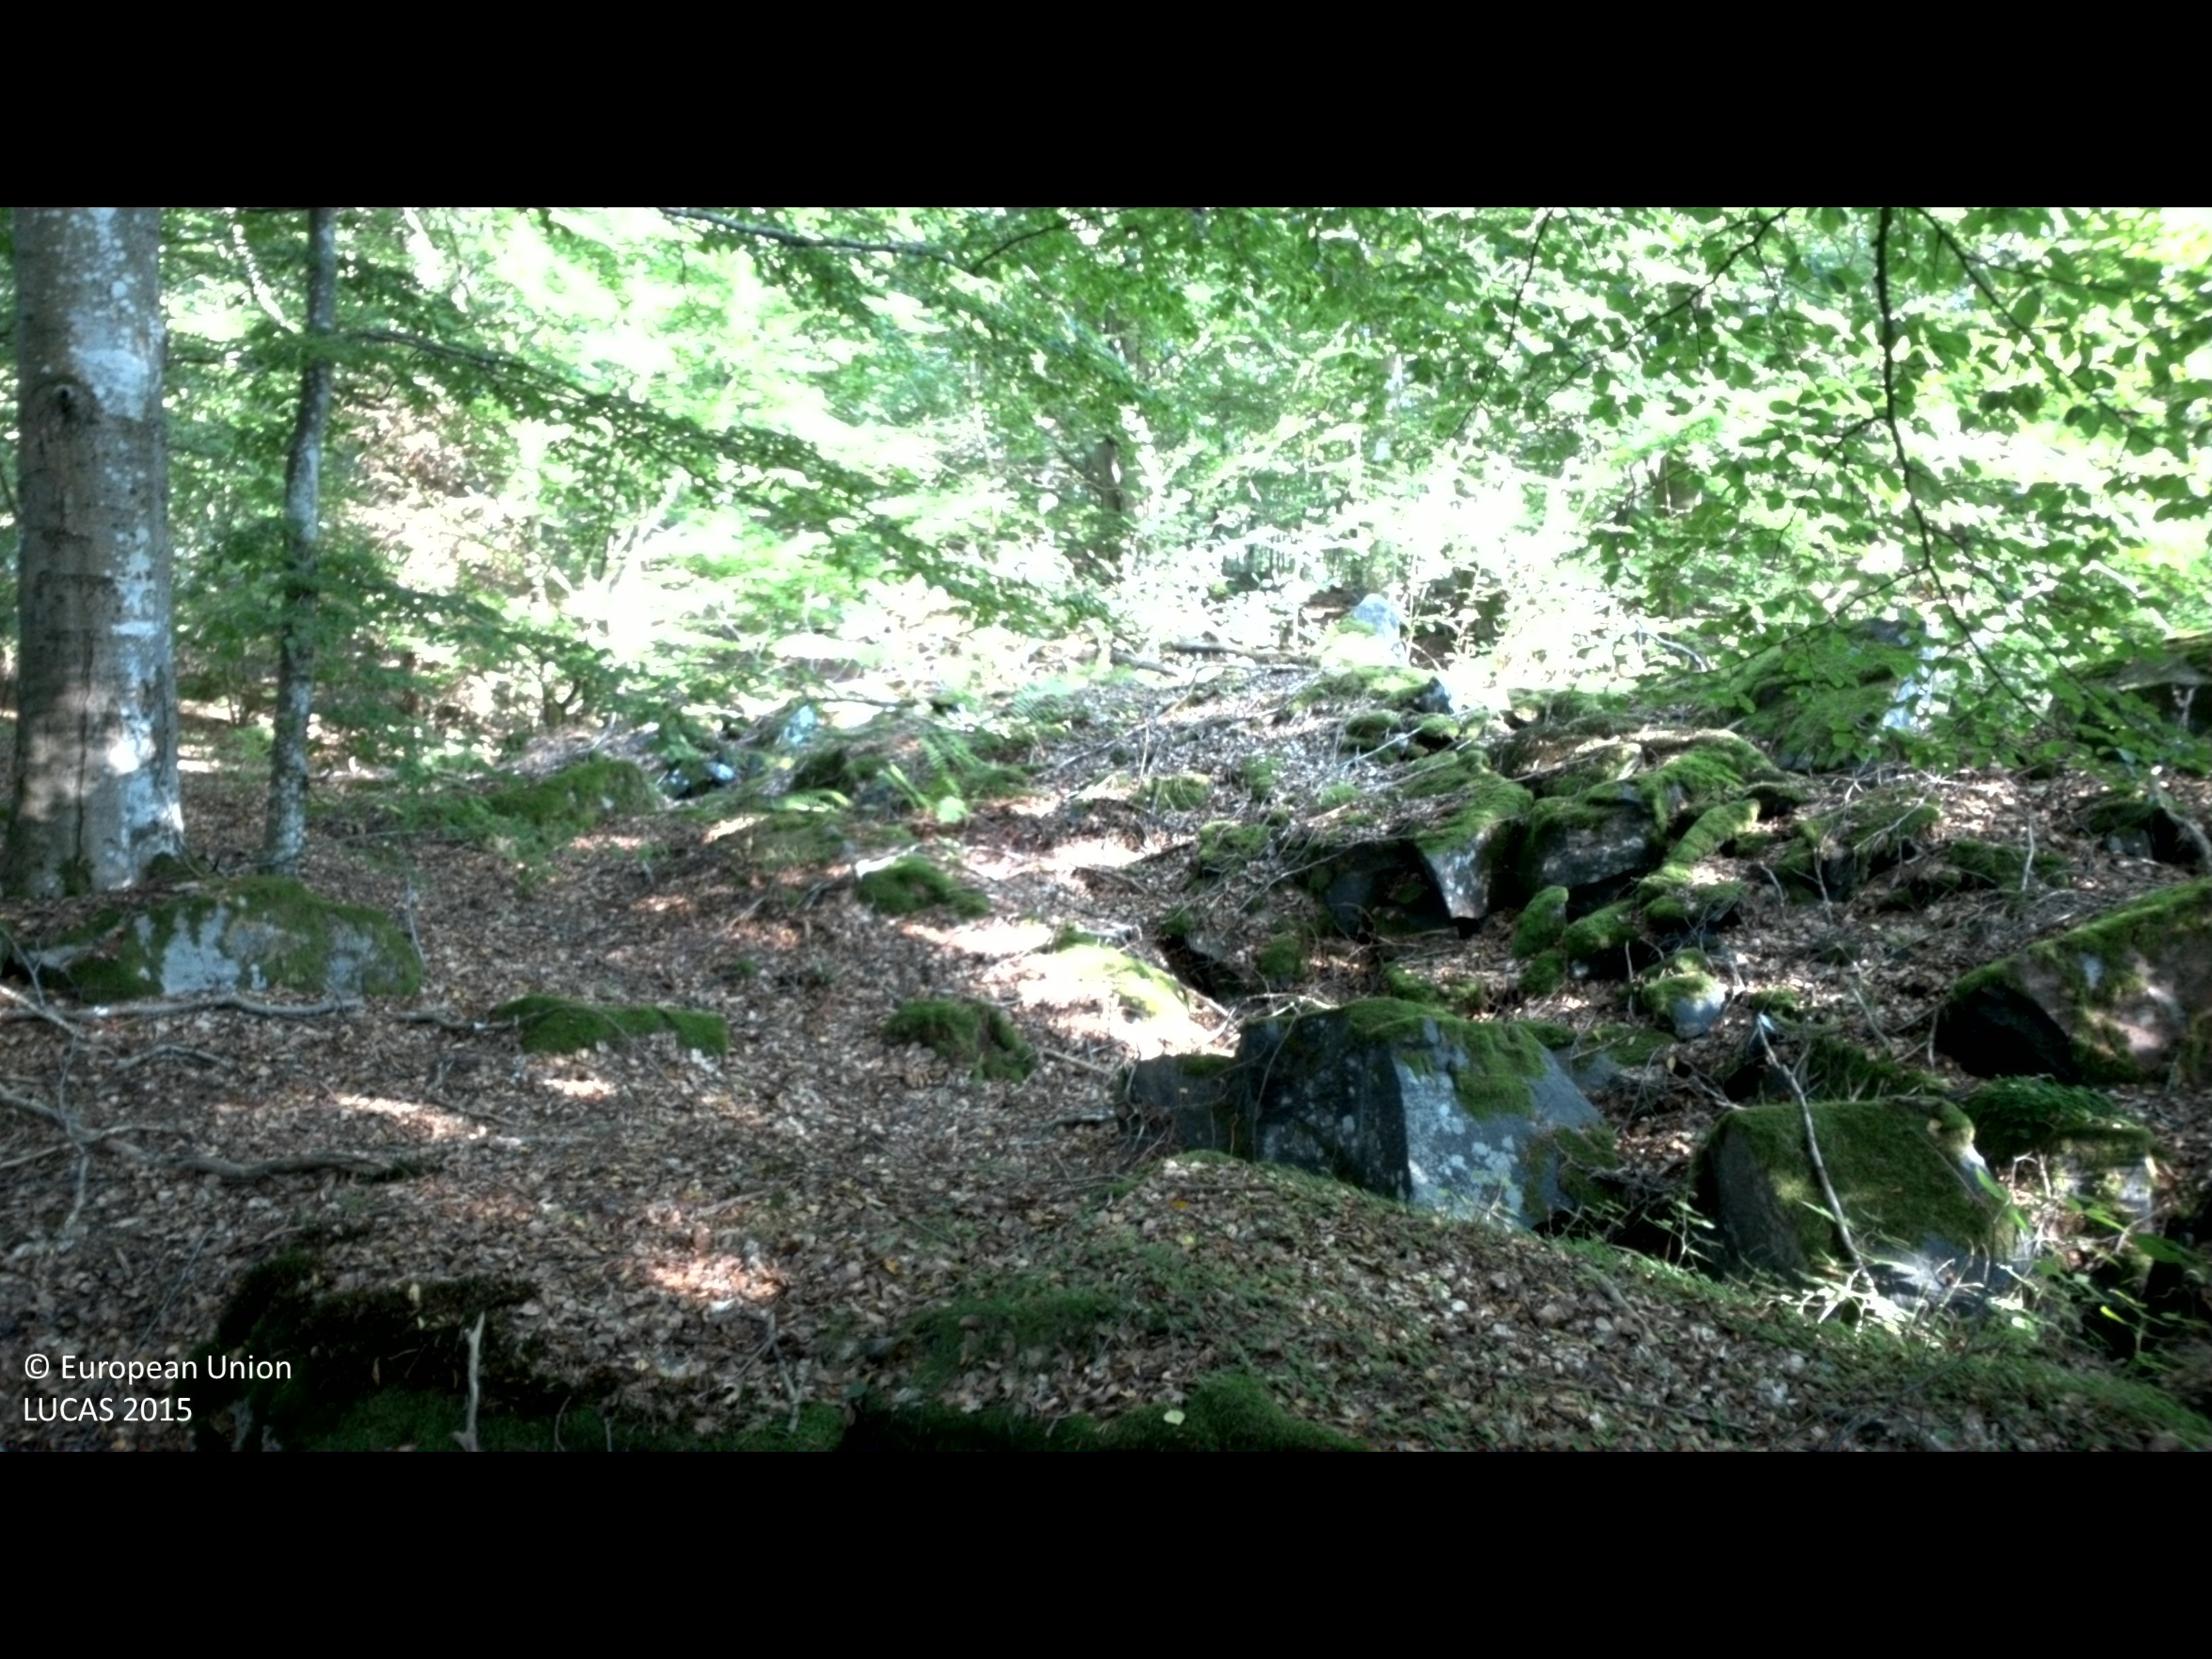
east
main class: Woodland
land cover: Broadleaved woodland
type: beech forest
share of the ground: > 75 %
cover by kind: broadleaved forest trees 80 %
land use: Forestry
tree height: > 5 m
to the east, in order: Broadleaved woodland; Dry stone walls; Broadleaved woodland; Dry stone walls; Broadleaved woodland
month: September
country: SE
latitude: 56.1720
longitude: 14.2338
